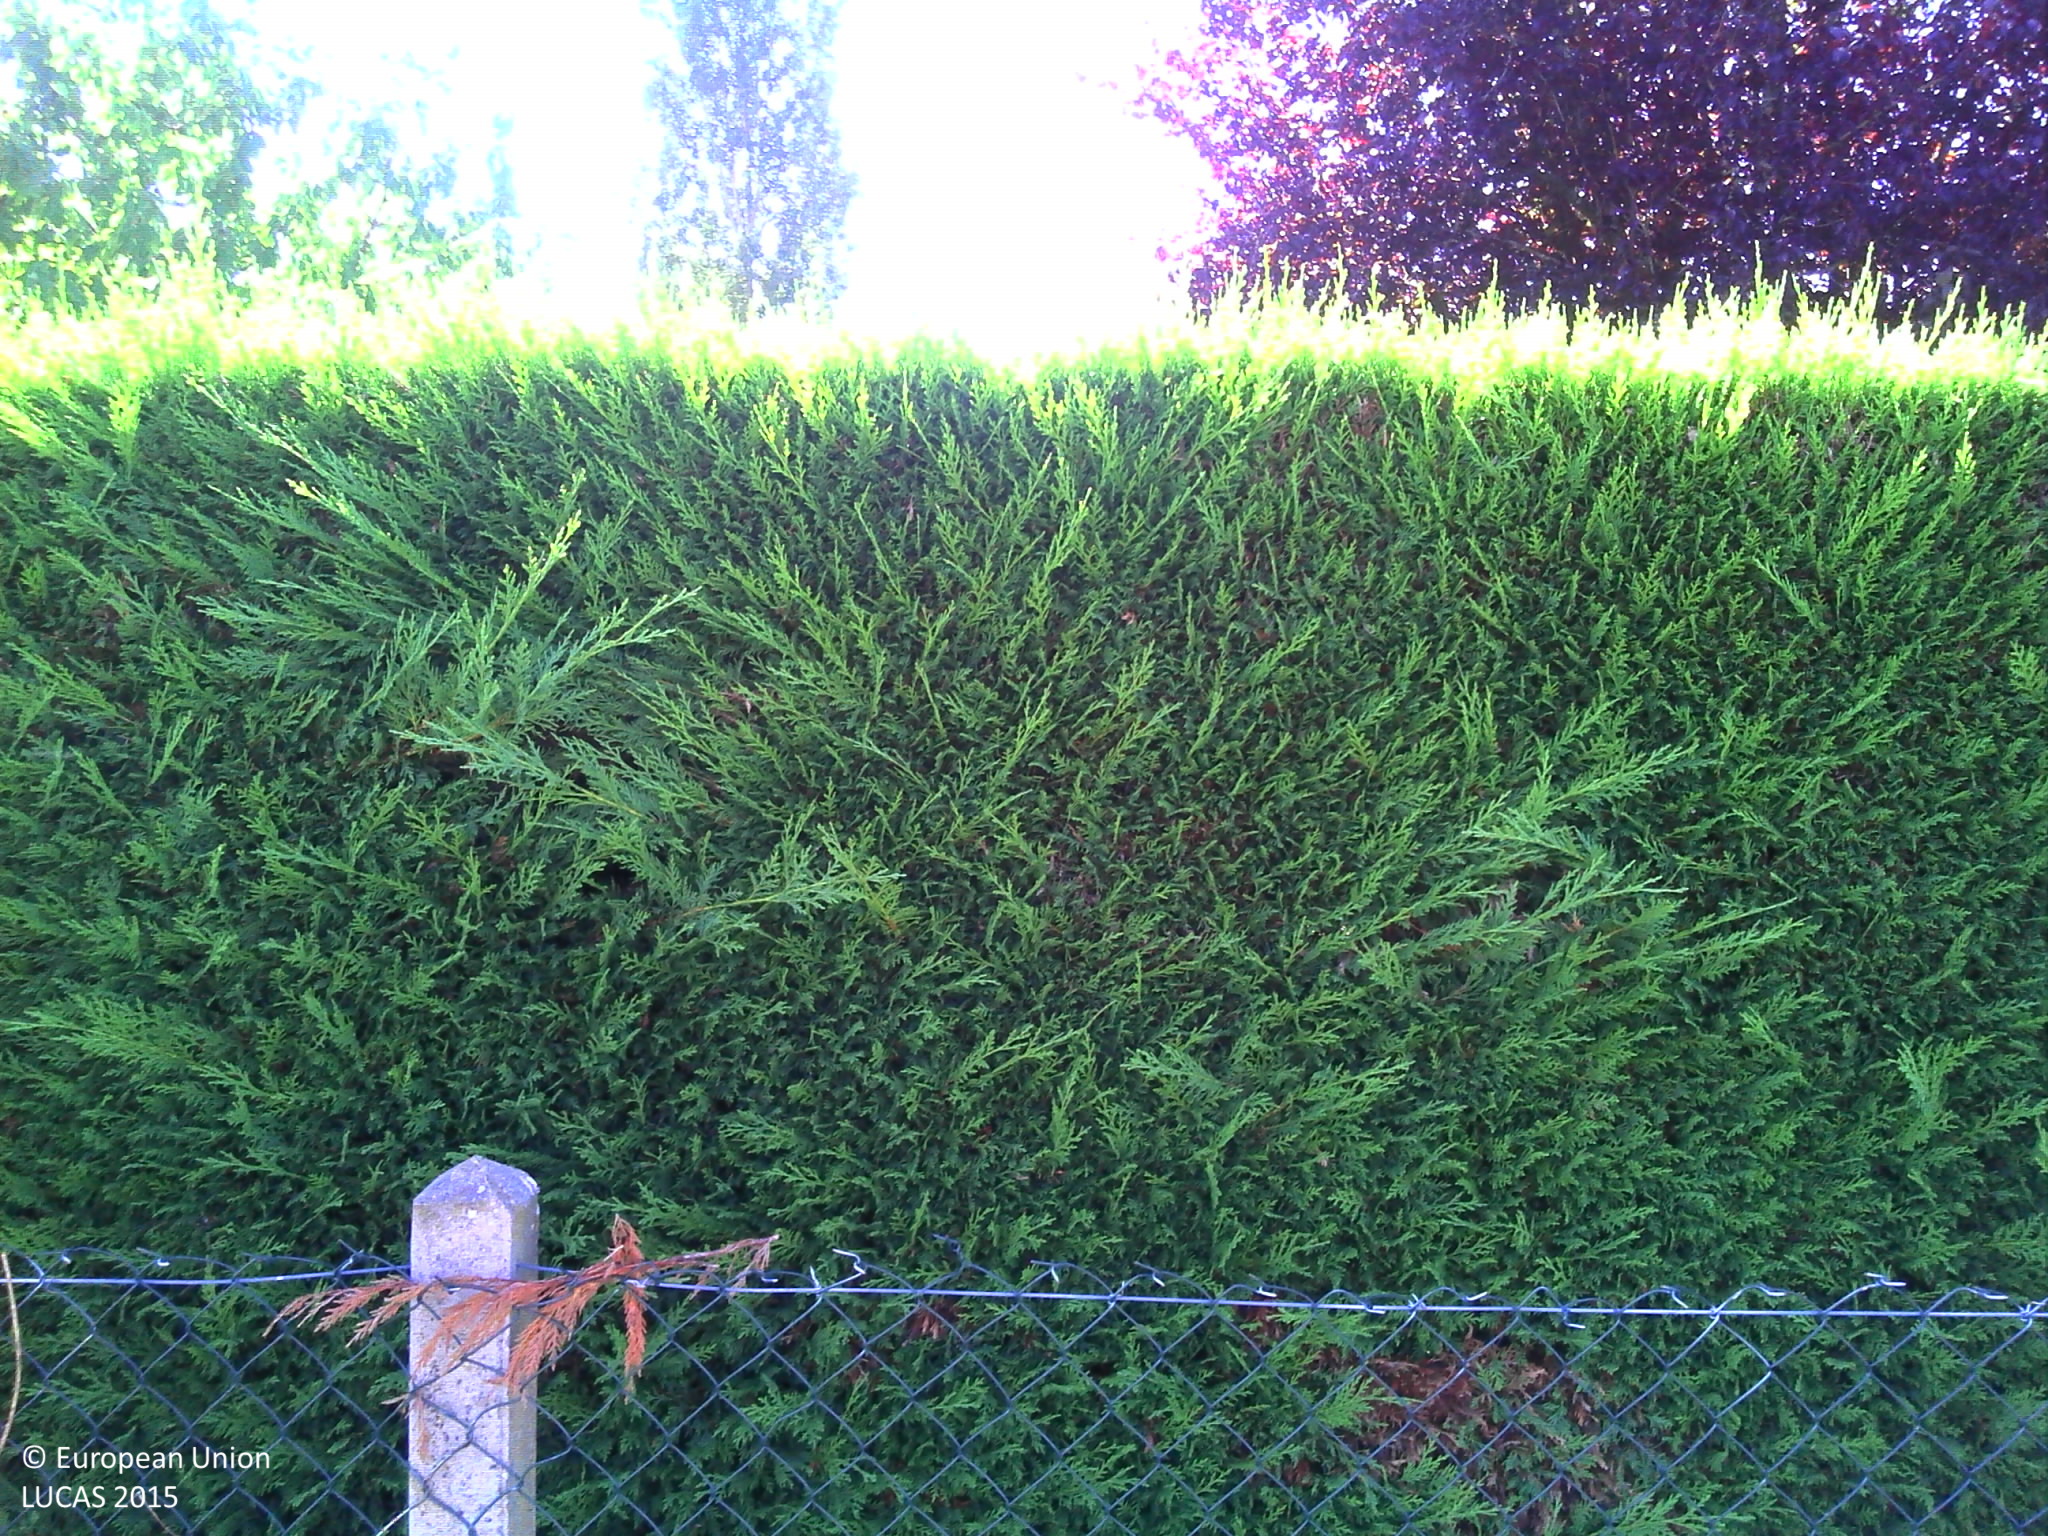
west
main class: Cropland
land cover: Floriculture and ornamental plants
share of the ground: > 75 %
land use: Agriculture (excluding fallow land and kitchen gardens)
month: July
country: FR
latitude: 44.0491
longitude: -0.5349
